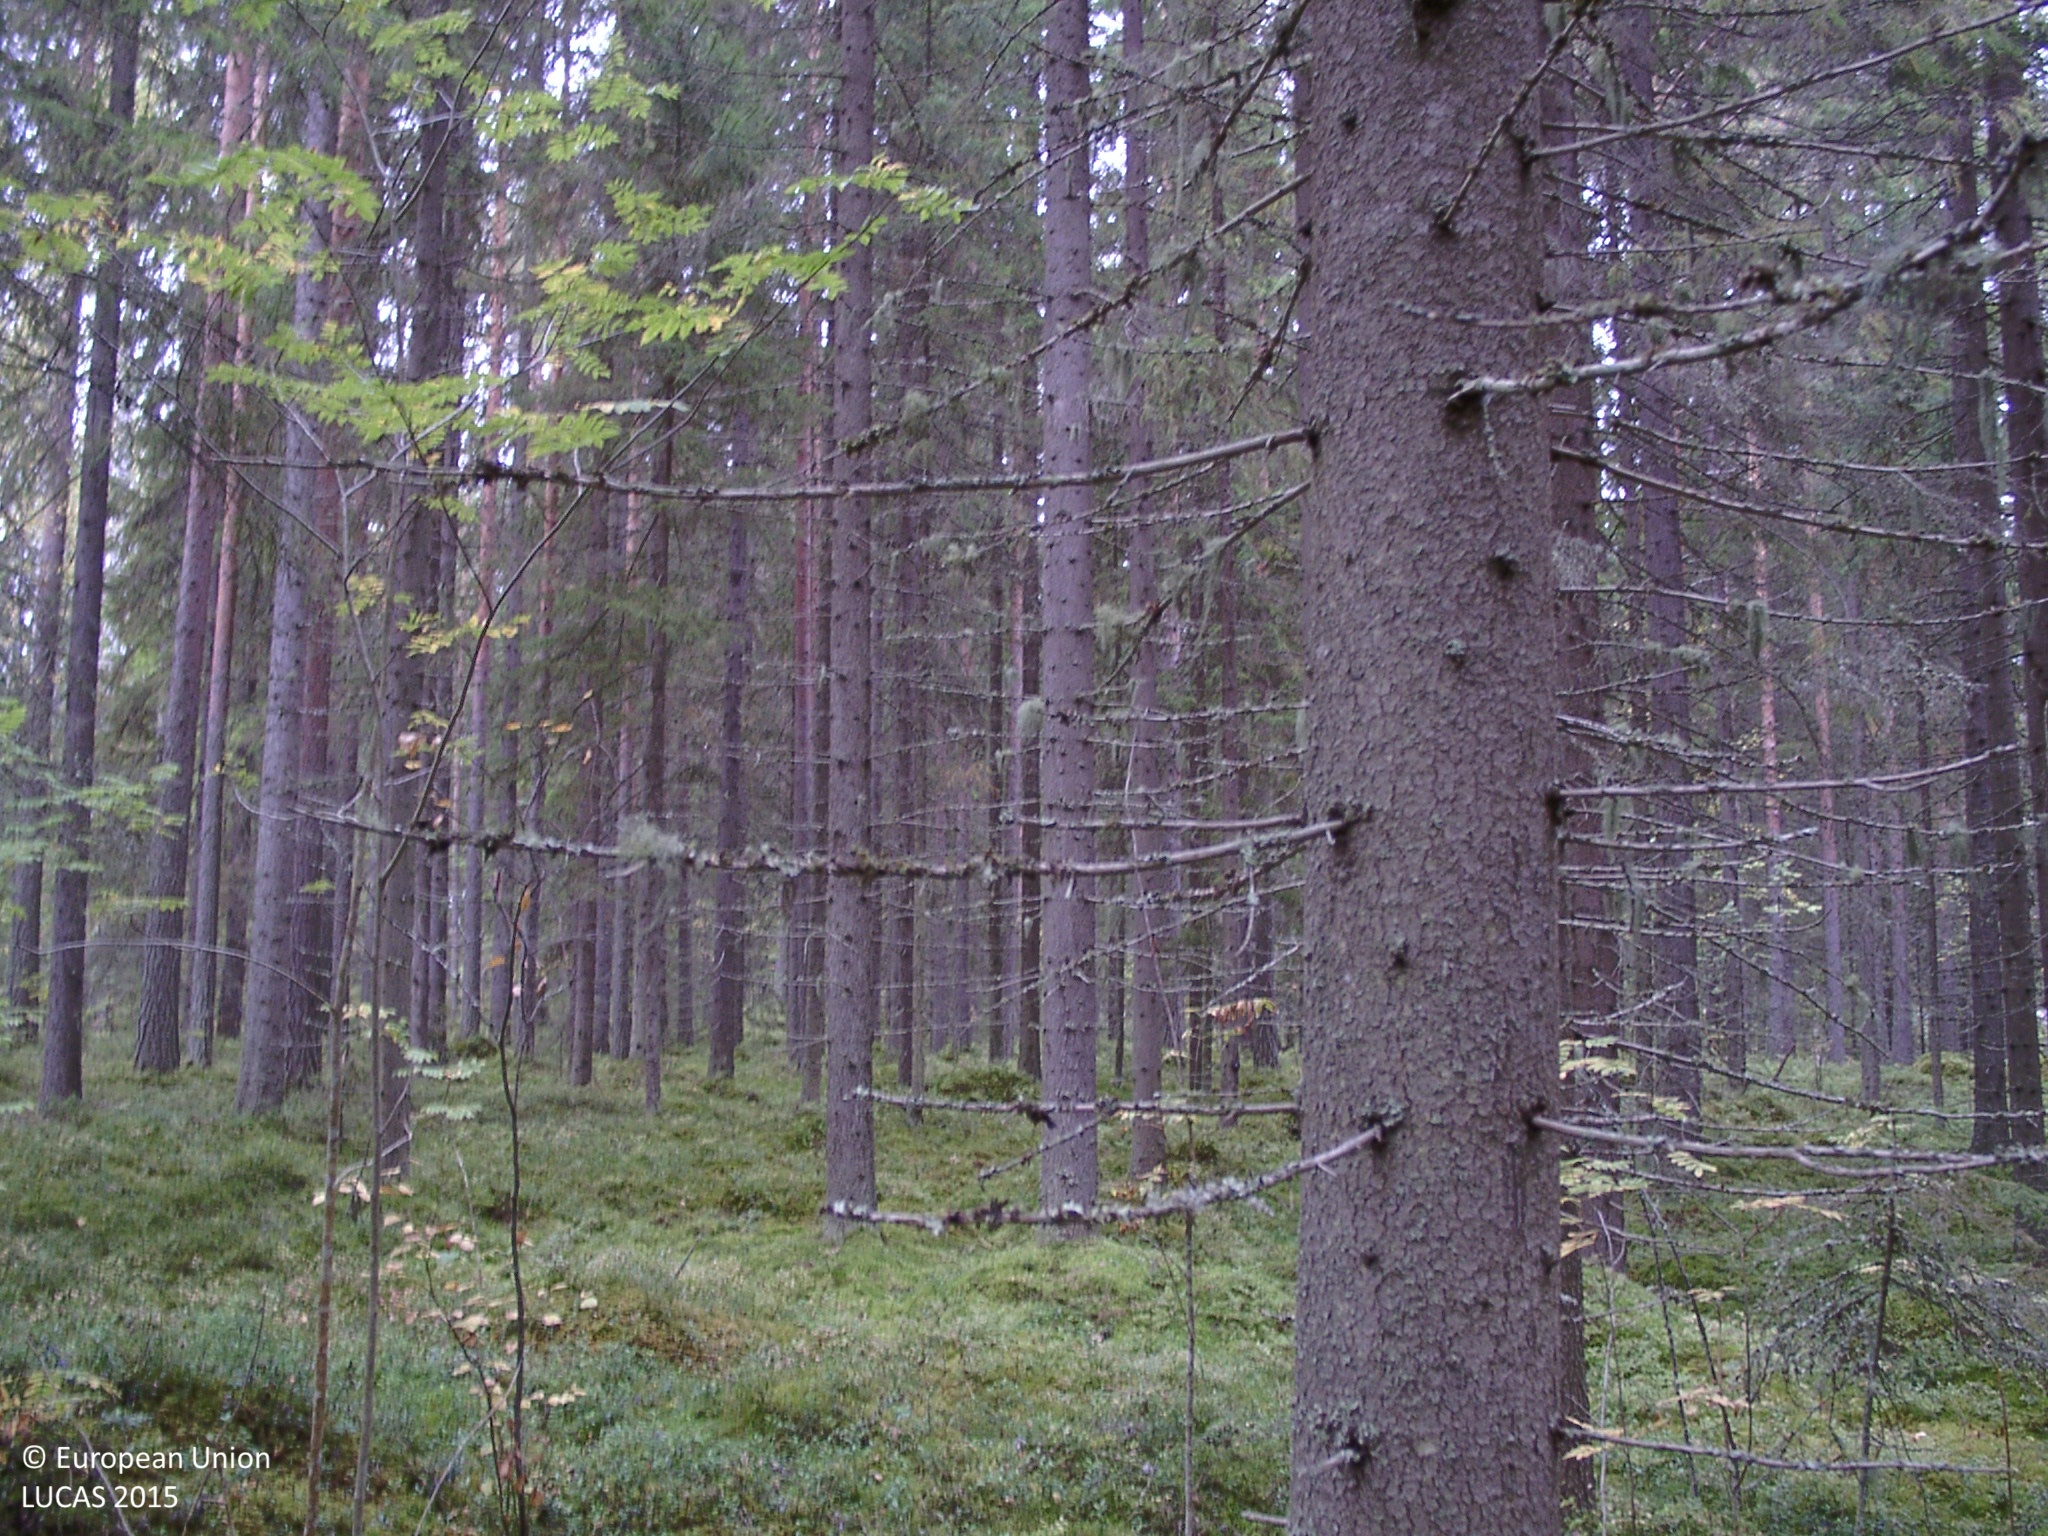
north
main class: Woodland
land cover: Spruce dominated coniferous woodland
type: boreal forest
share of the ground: > 75 %
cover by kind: coniferous forest trees 70 %, lichens and mosses 15 %, broadleaved forest trees 10 %, shrubs 5 %
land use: Forestry
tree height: > 5 m
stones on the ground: < 10 %
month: September
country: FI
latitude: 62.6481
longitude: 25.7032
